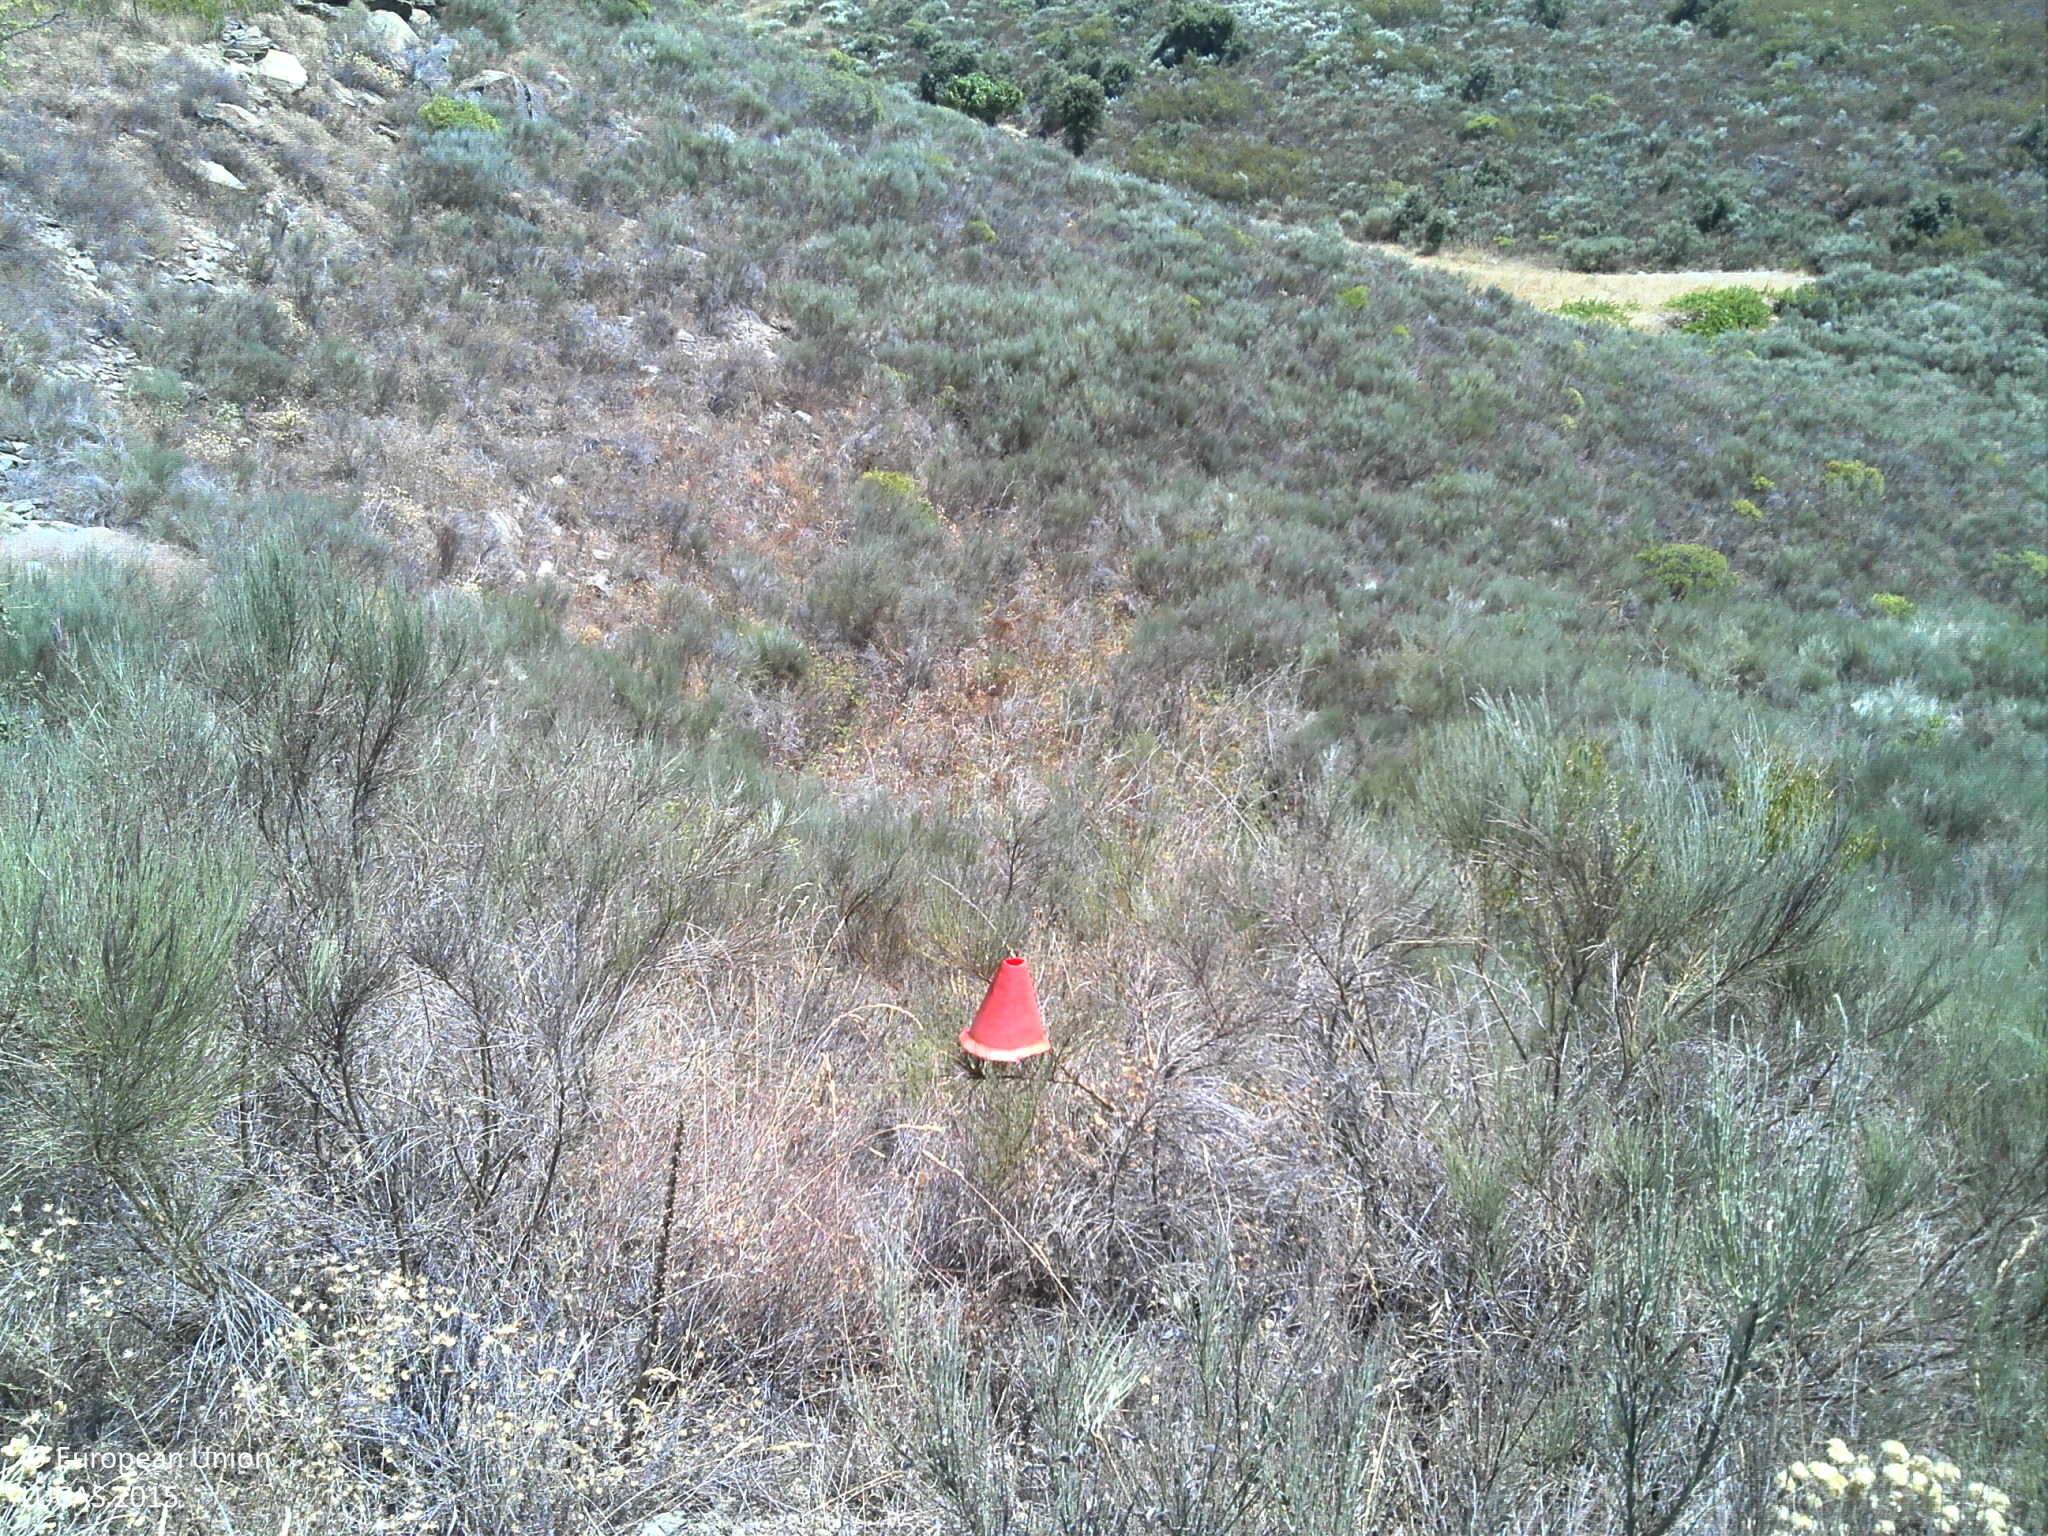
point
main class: Shrubland
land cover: Shrubland without tree cover
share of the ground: > 75 %
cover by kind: shrubs 100 %
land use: Semi-natural and natural areas not in use
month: July
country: PT
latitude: 41.0984
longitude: -7.3941
